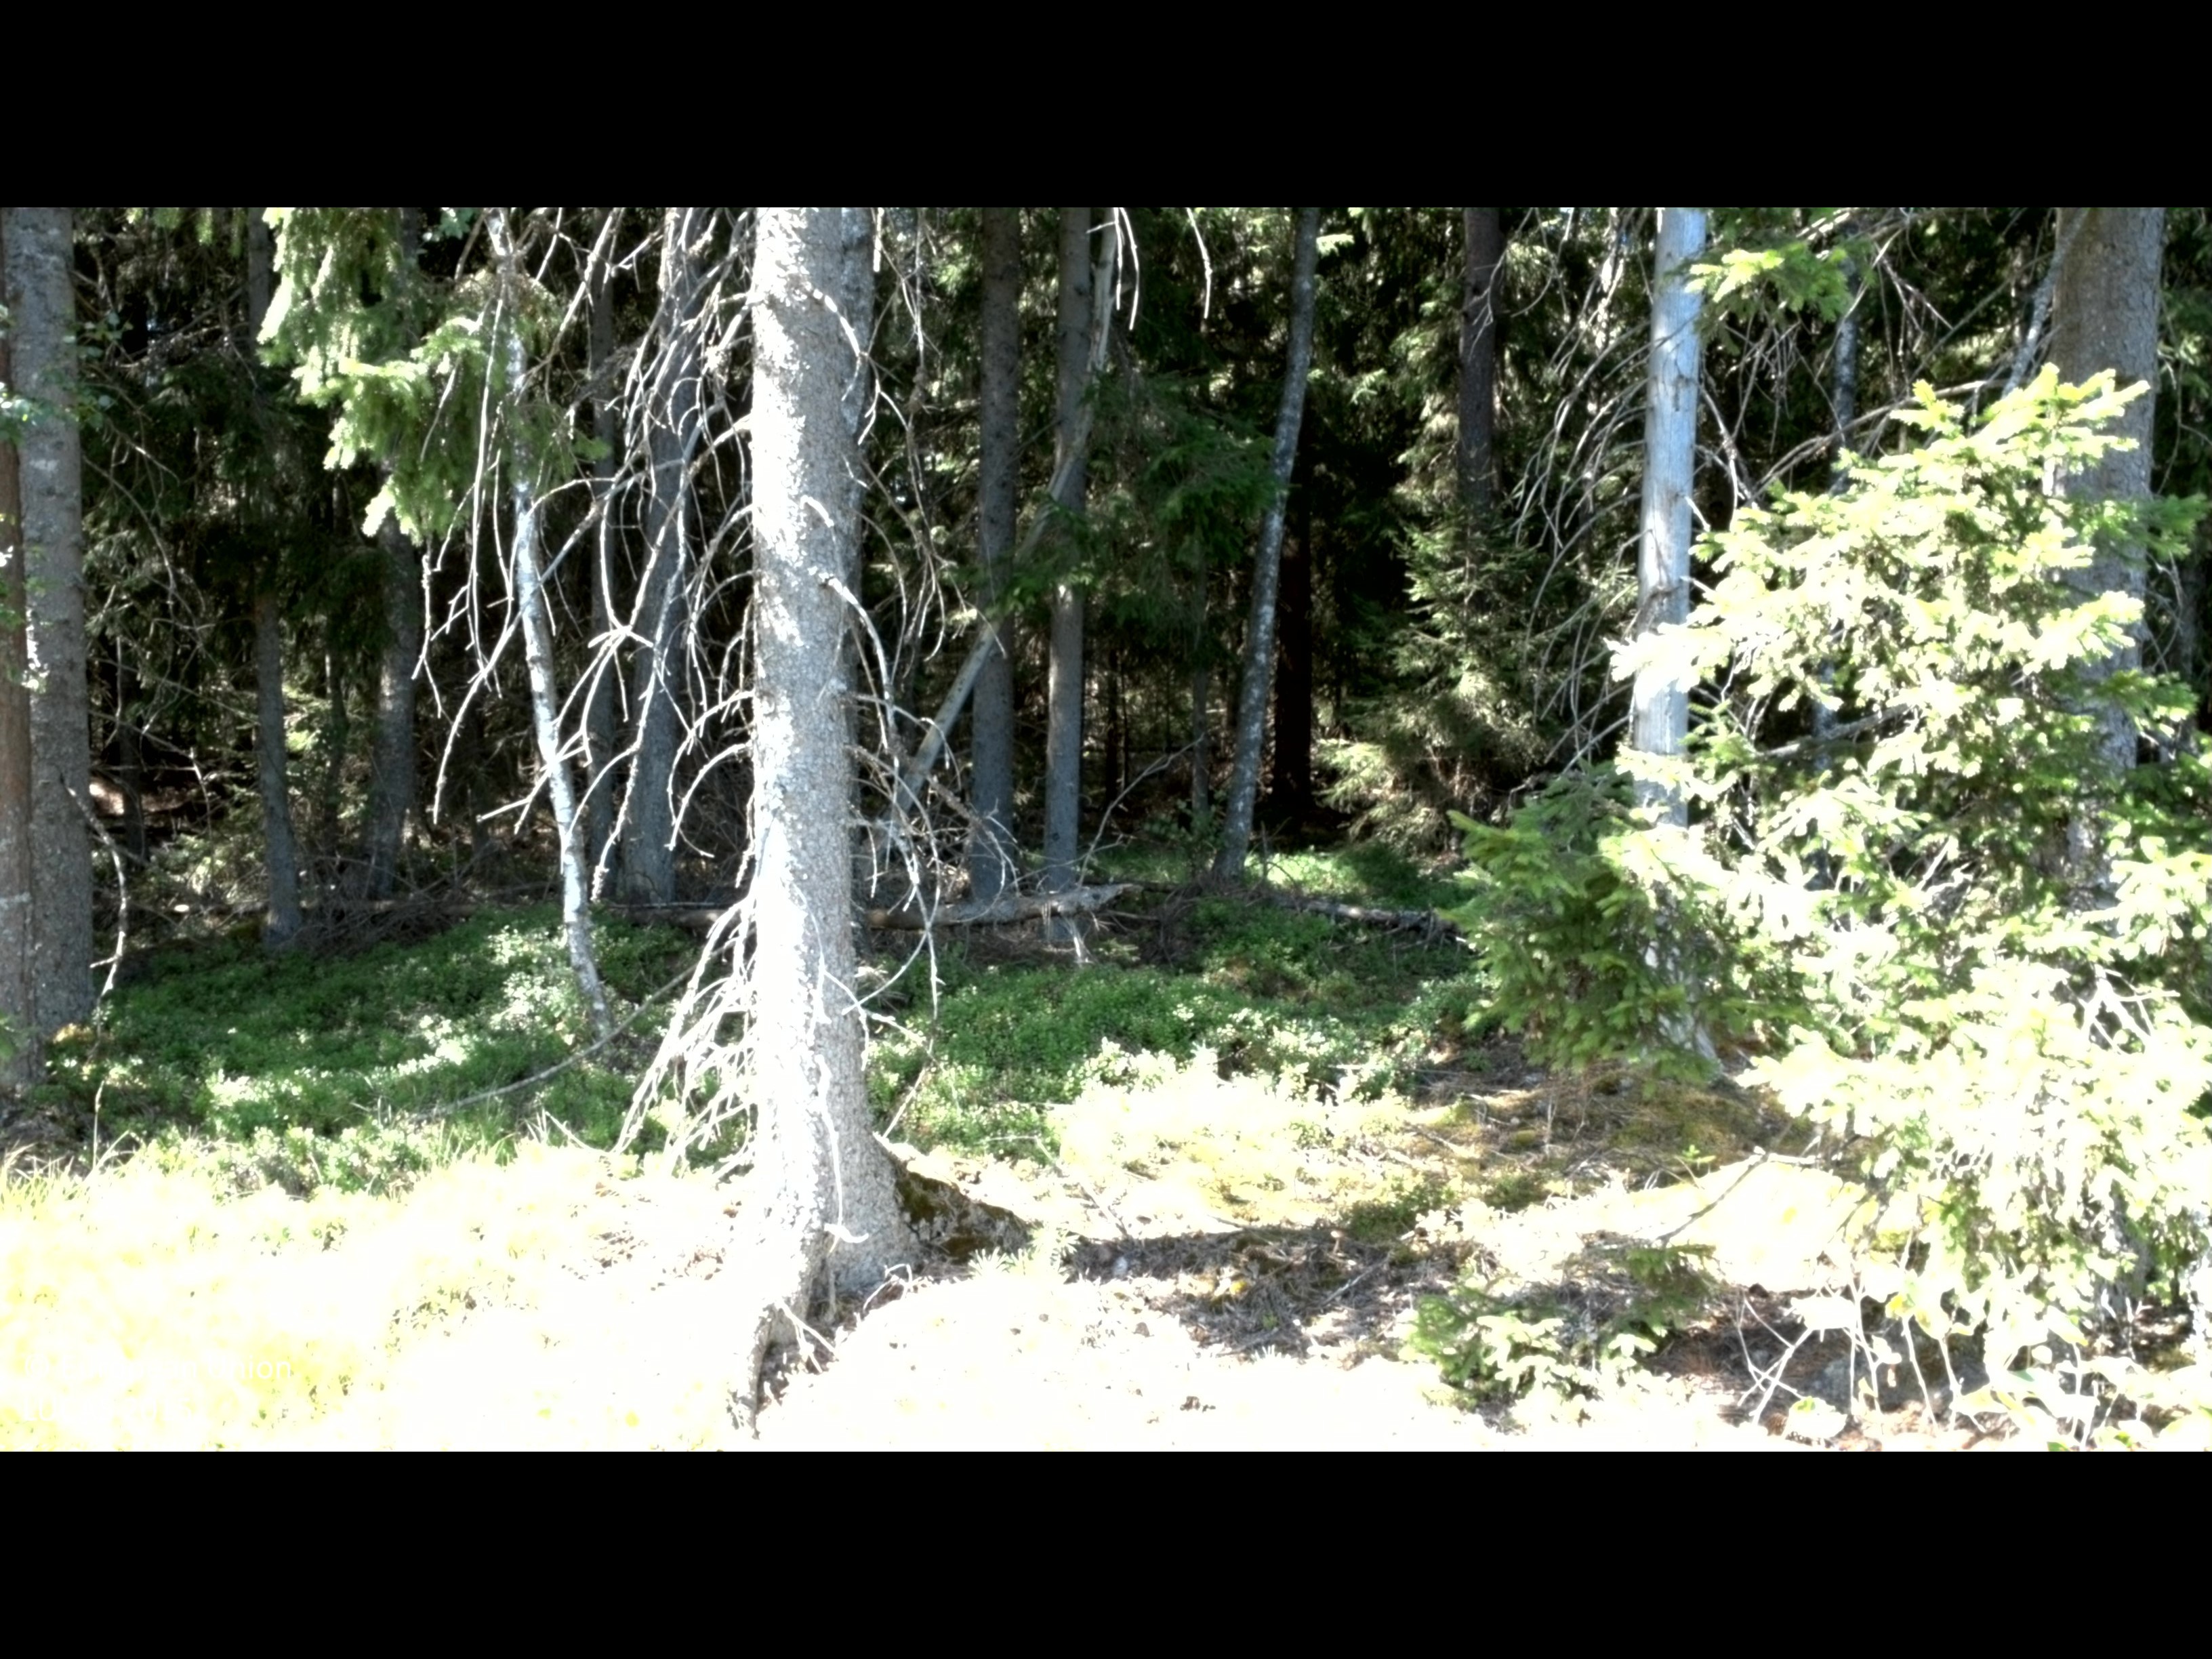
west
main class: Woodland
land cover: Spruce dominated mixed woodland
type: boreal forest
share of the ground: > 75 %
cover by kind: broadleaved forest trees 55 %, coniferous forest trees 30 %, shrubs 10 %, herbaceous plants 5 %
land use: Forestry
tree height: > 5 m
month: August
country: SE
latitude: 56.7281
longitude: 14.2953
